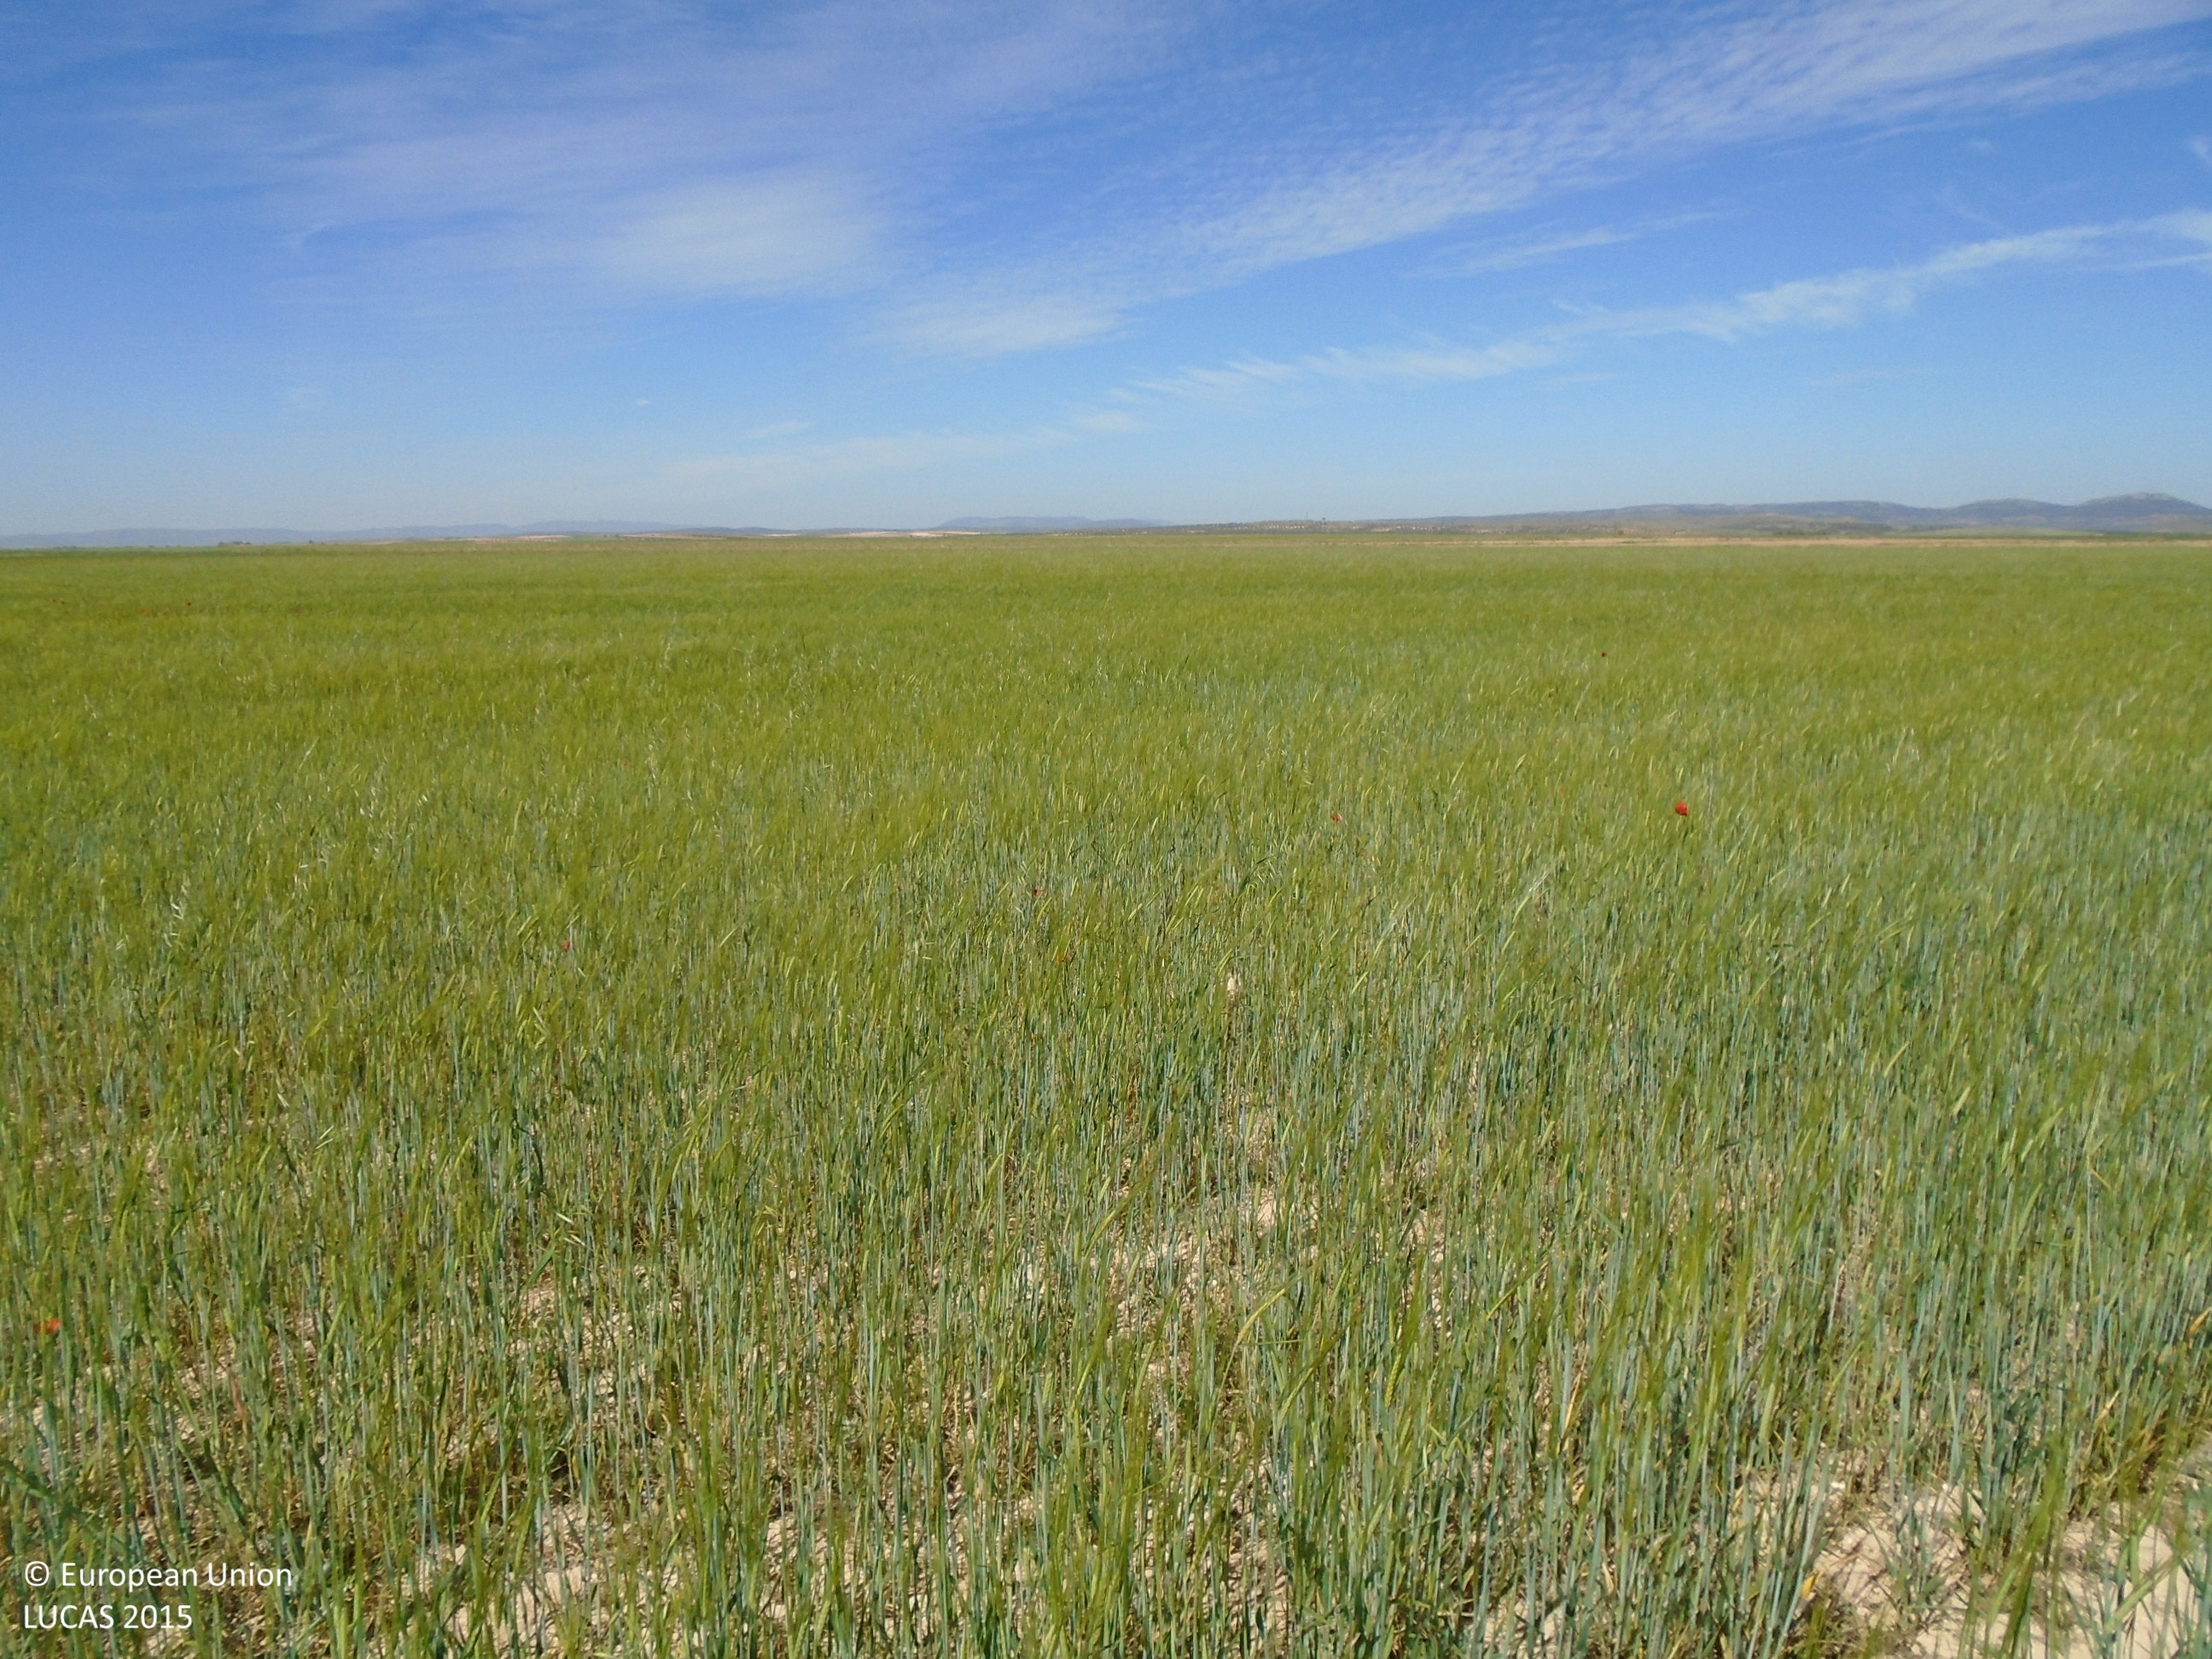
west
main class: Cropland
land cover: Barley
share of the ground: > 75 %
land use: Agriculture (excluding fallow land and kitchen gardens)
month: May
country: ES
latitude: 39.6304
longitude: -3.5752
